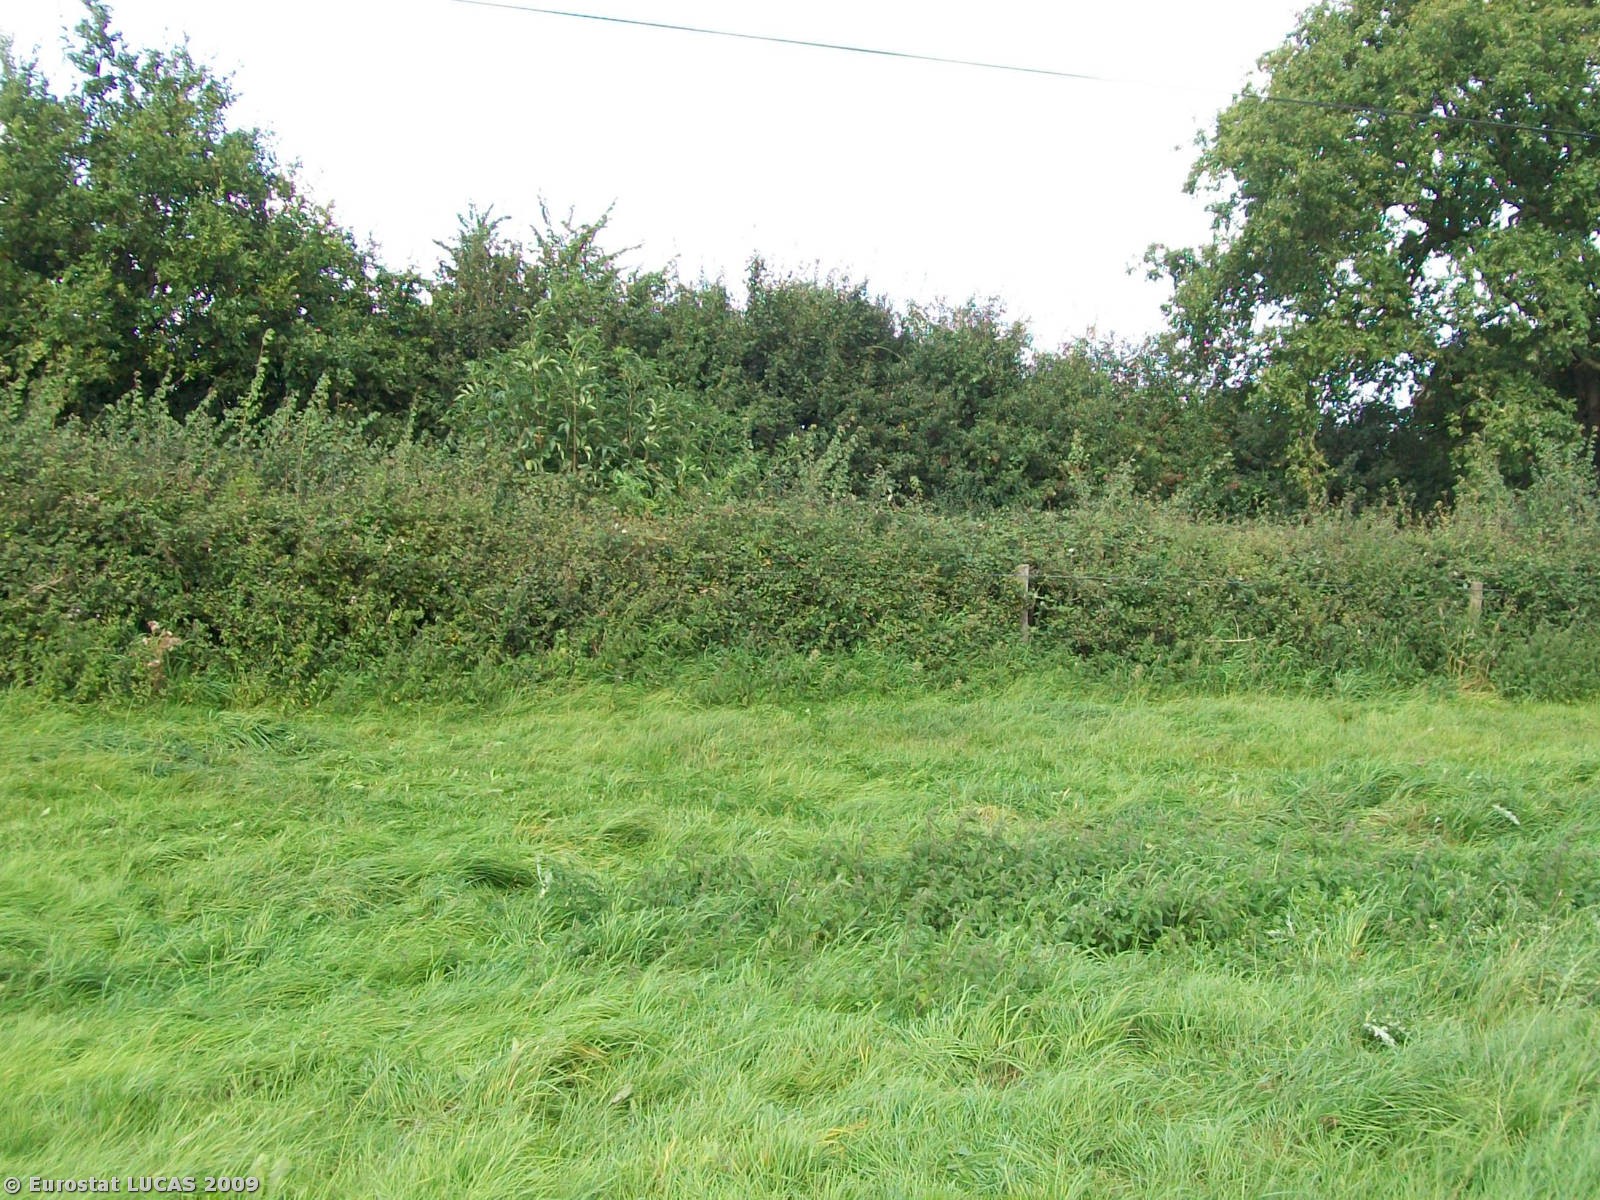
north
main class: Grassland
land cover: Grassland without tree/shrub cover
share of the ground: > 75 %
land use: Agriculture (excluding fallow land and kitchen gardens)
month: August
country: GB
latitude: 51.9854
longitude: -2.3388
